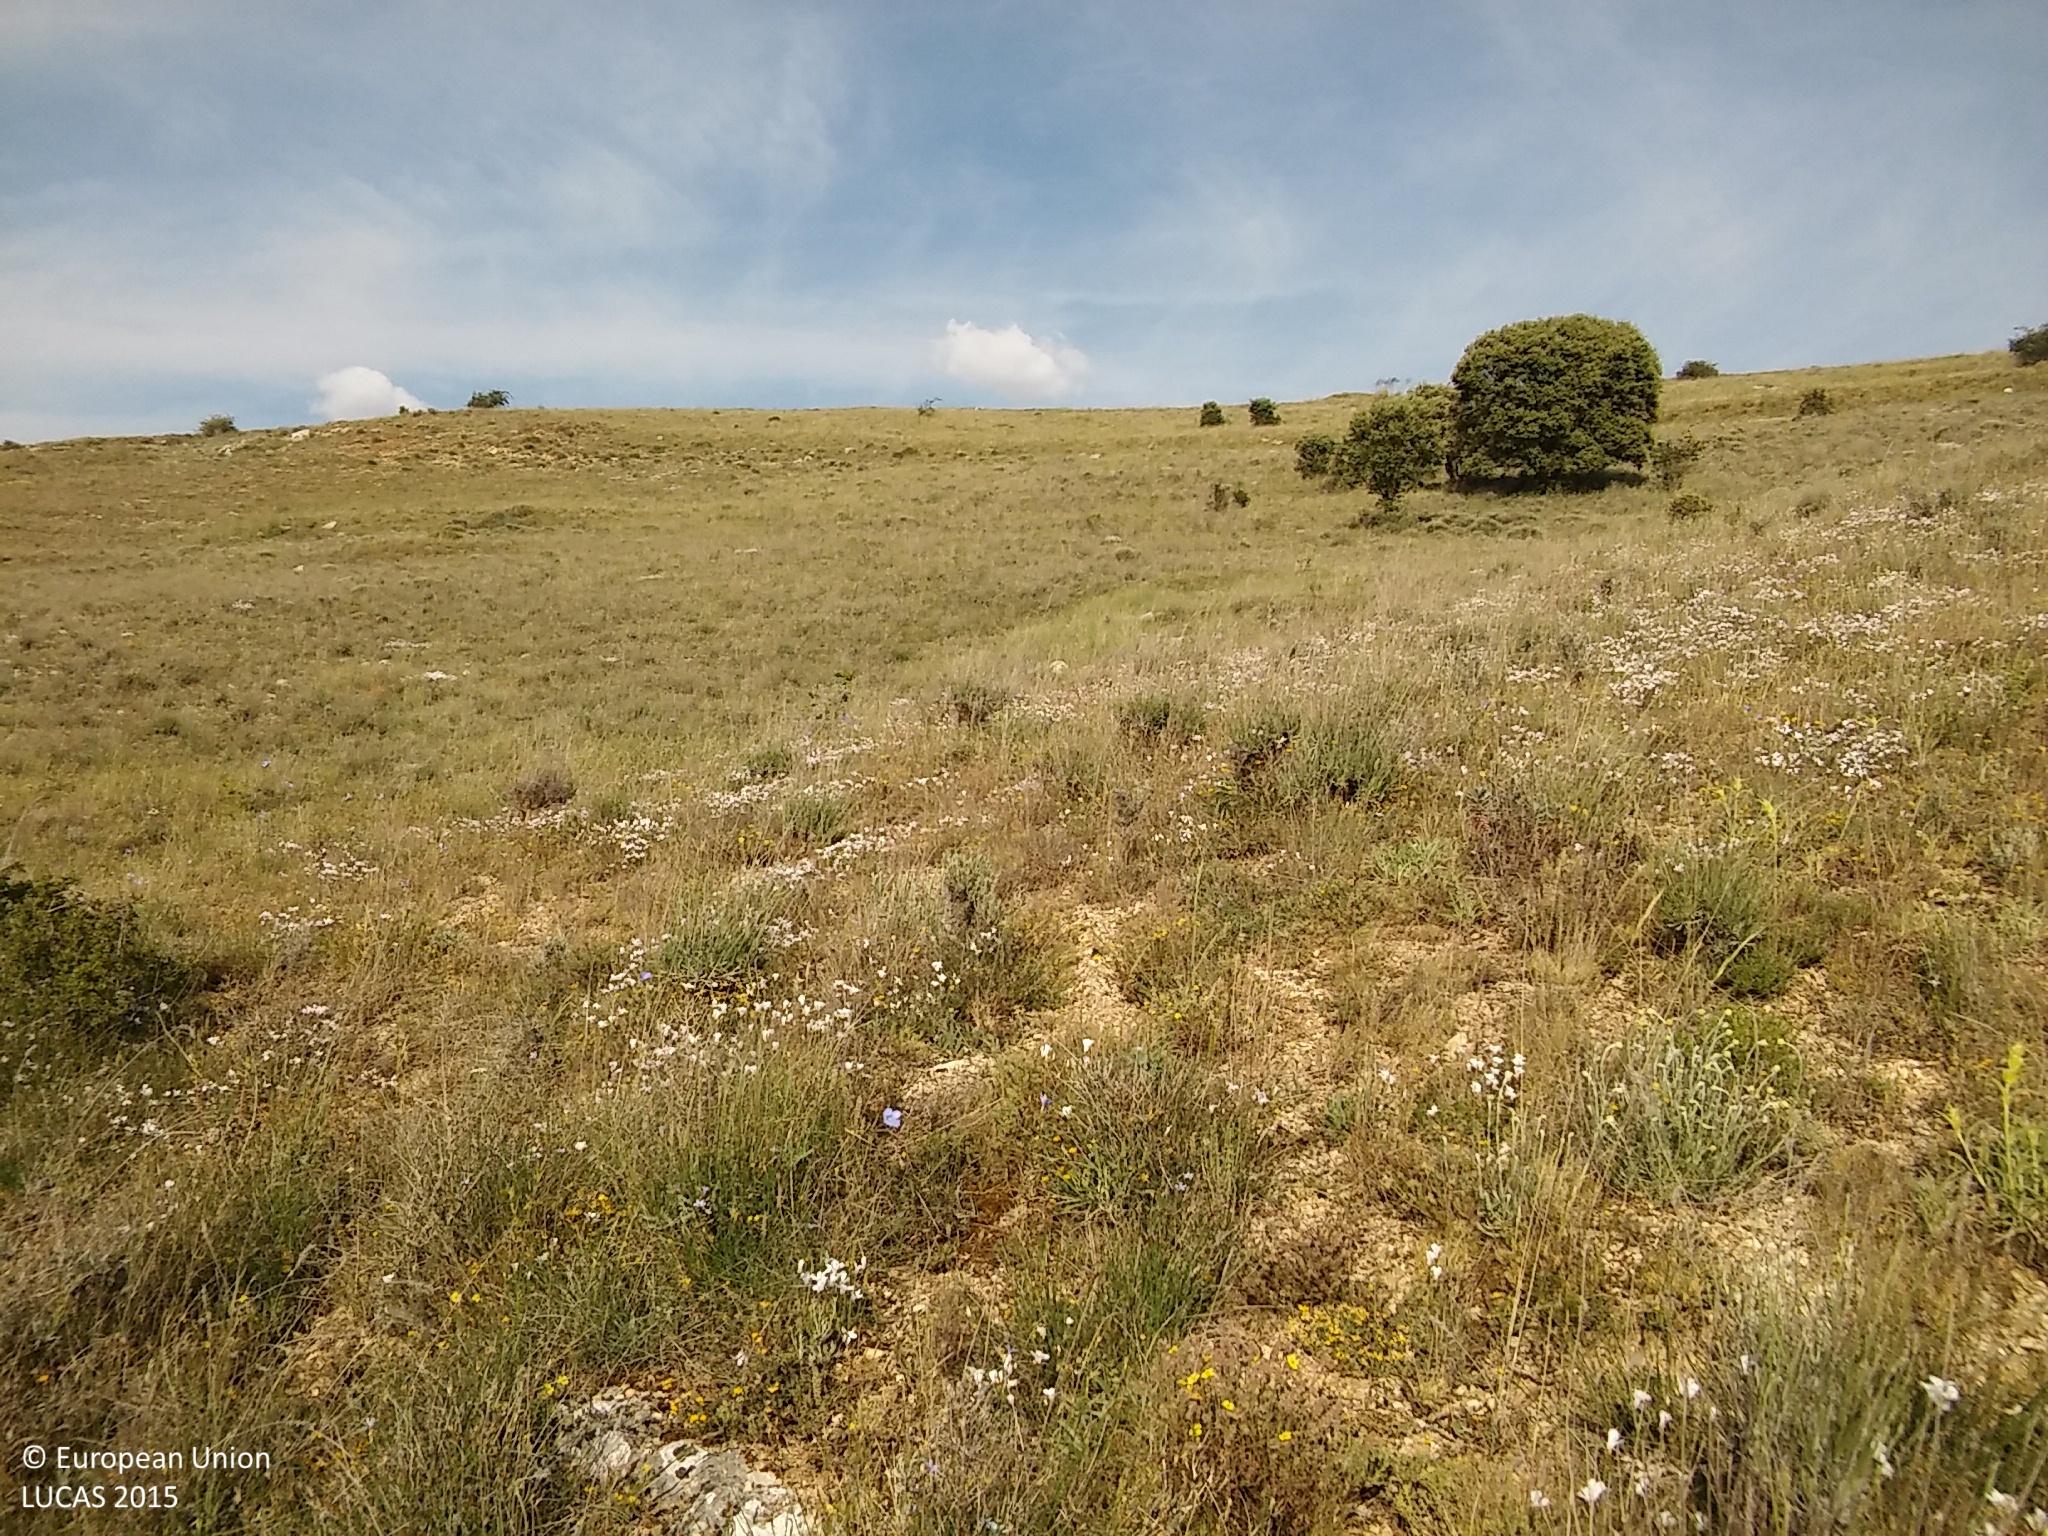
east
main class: Shrubland
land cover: Shrubland without tree cover
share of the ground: 25 - 50 %
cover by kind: shrubs 45 %, herbaceous plants 30 %, unconsolidated bare surface 25 %
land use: Semi-natural and natural areas not in use
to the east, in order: Shrubland without tree cover; Shrubland with sparse tree cover; Tracks; Shrubland with sparse tree cover
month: June
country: ES
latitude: 41.5670
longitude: -3.7349
